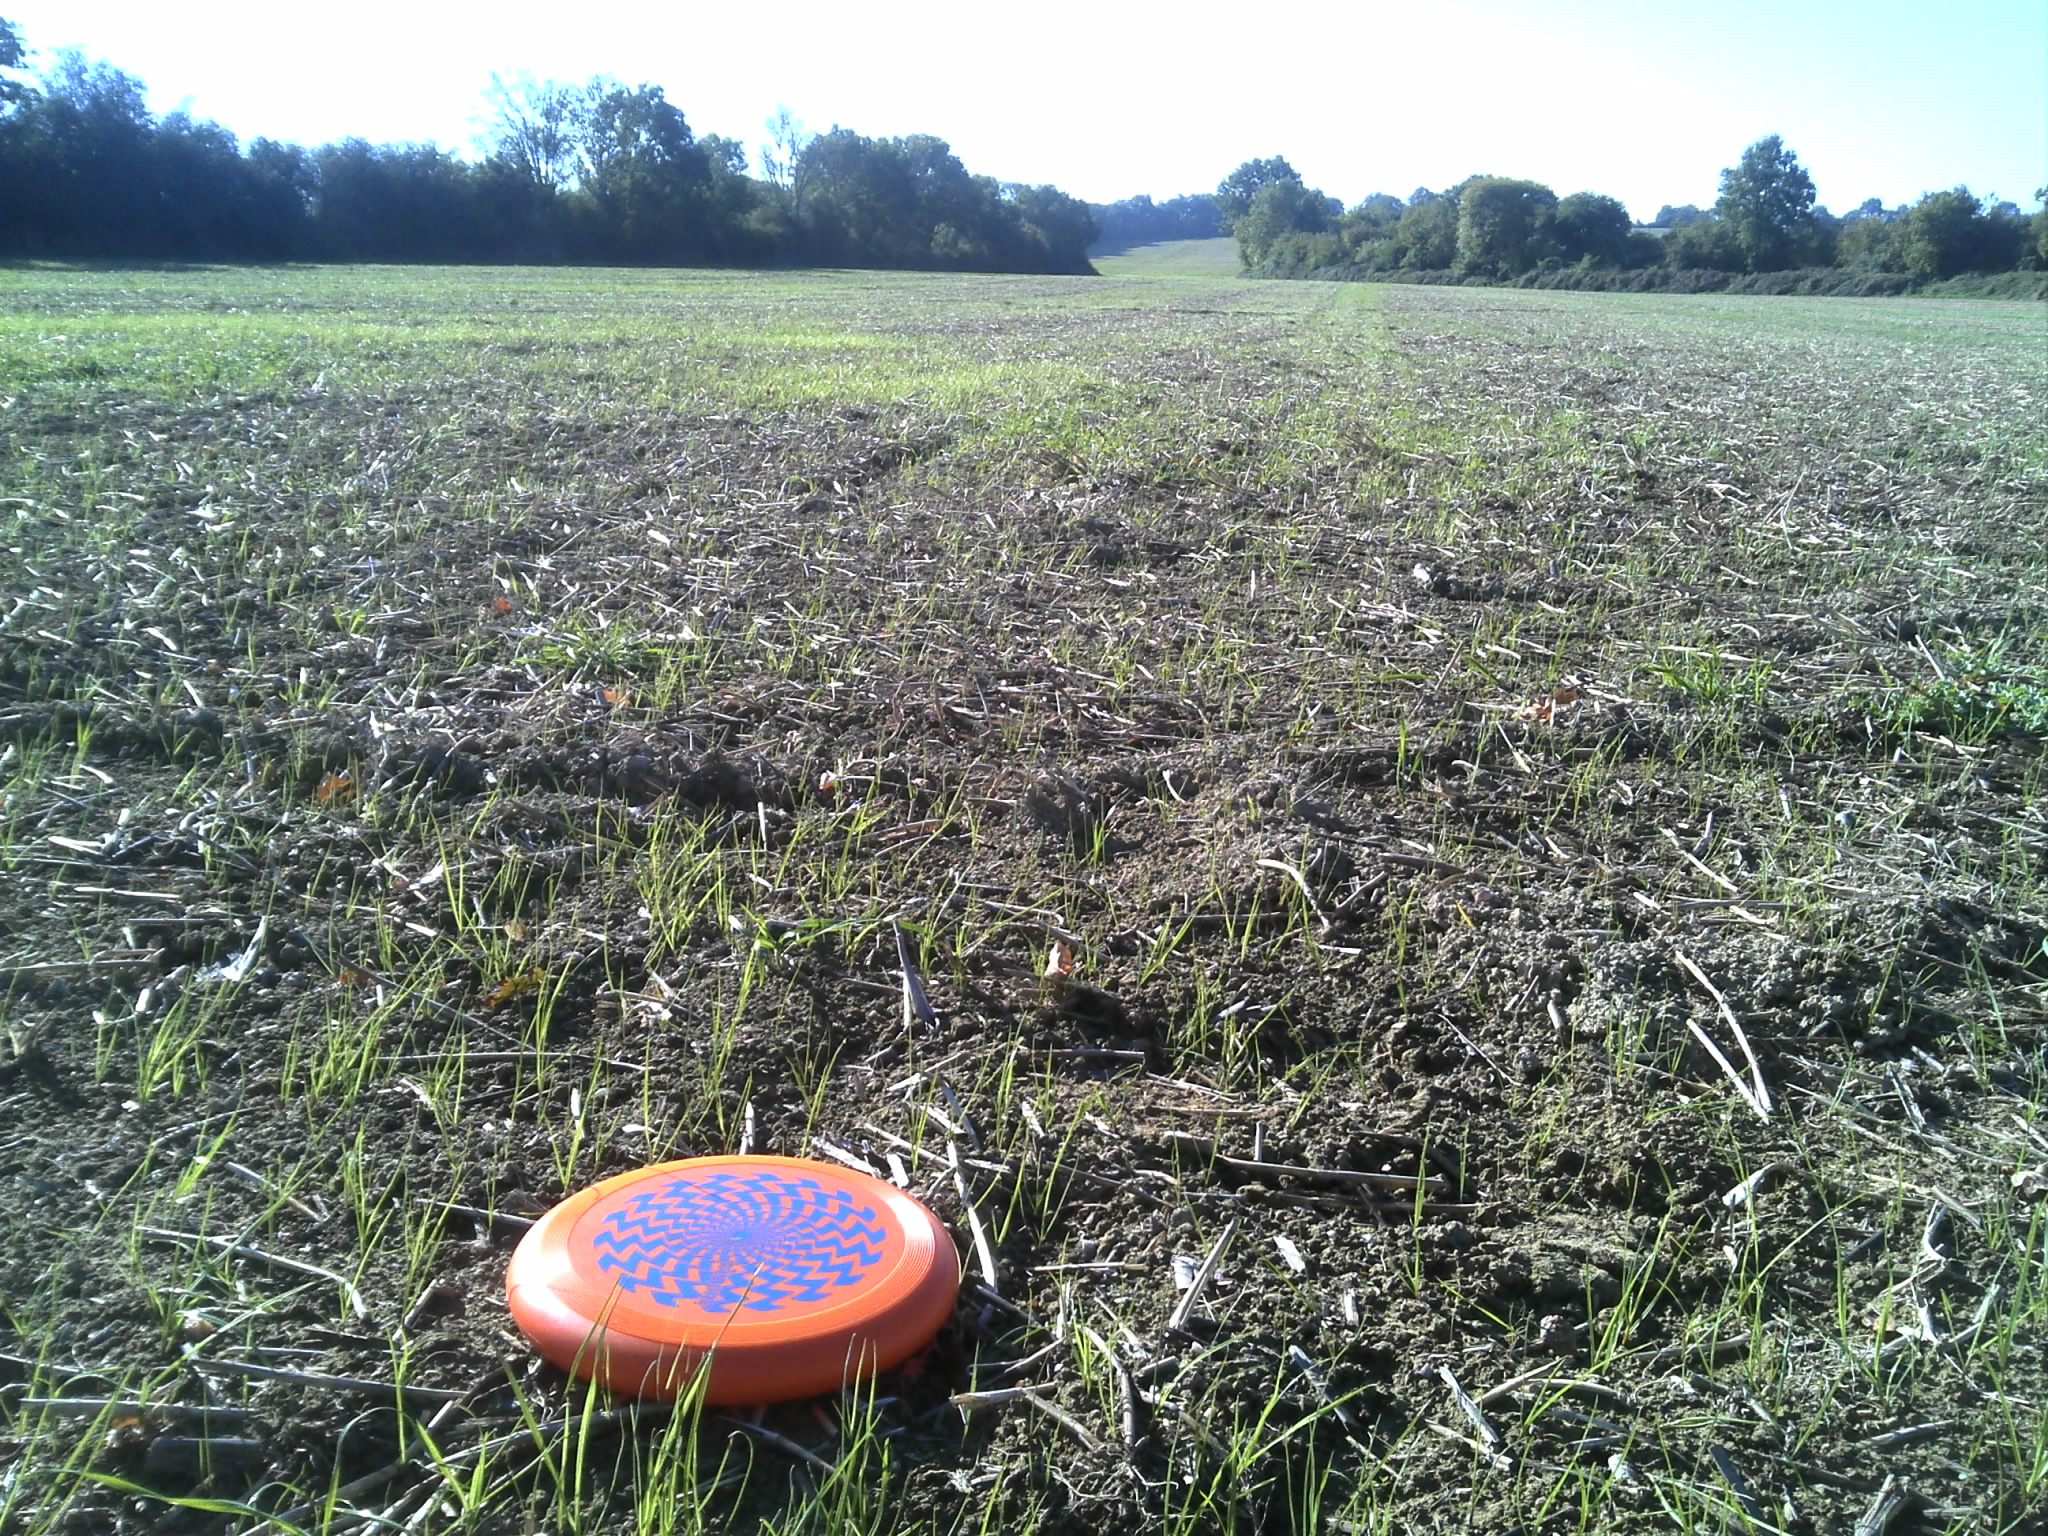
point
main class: Cropland
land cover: Temporary grasslands
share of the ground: > 75 %
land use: Agriculture (excluding fallow land and kitchen gardens)
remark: Harvested field
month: October
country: FR
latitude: 47.6279
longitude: -1.0699
